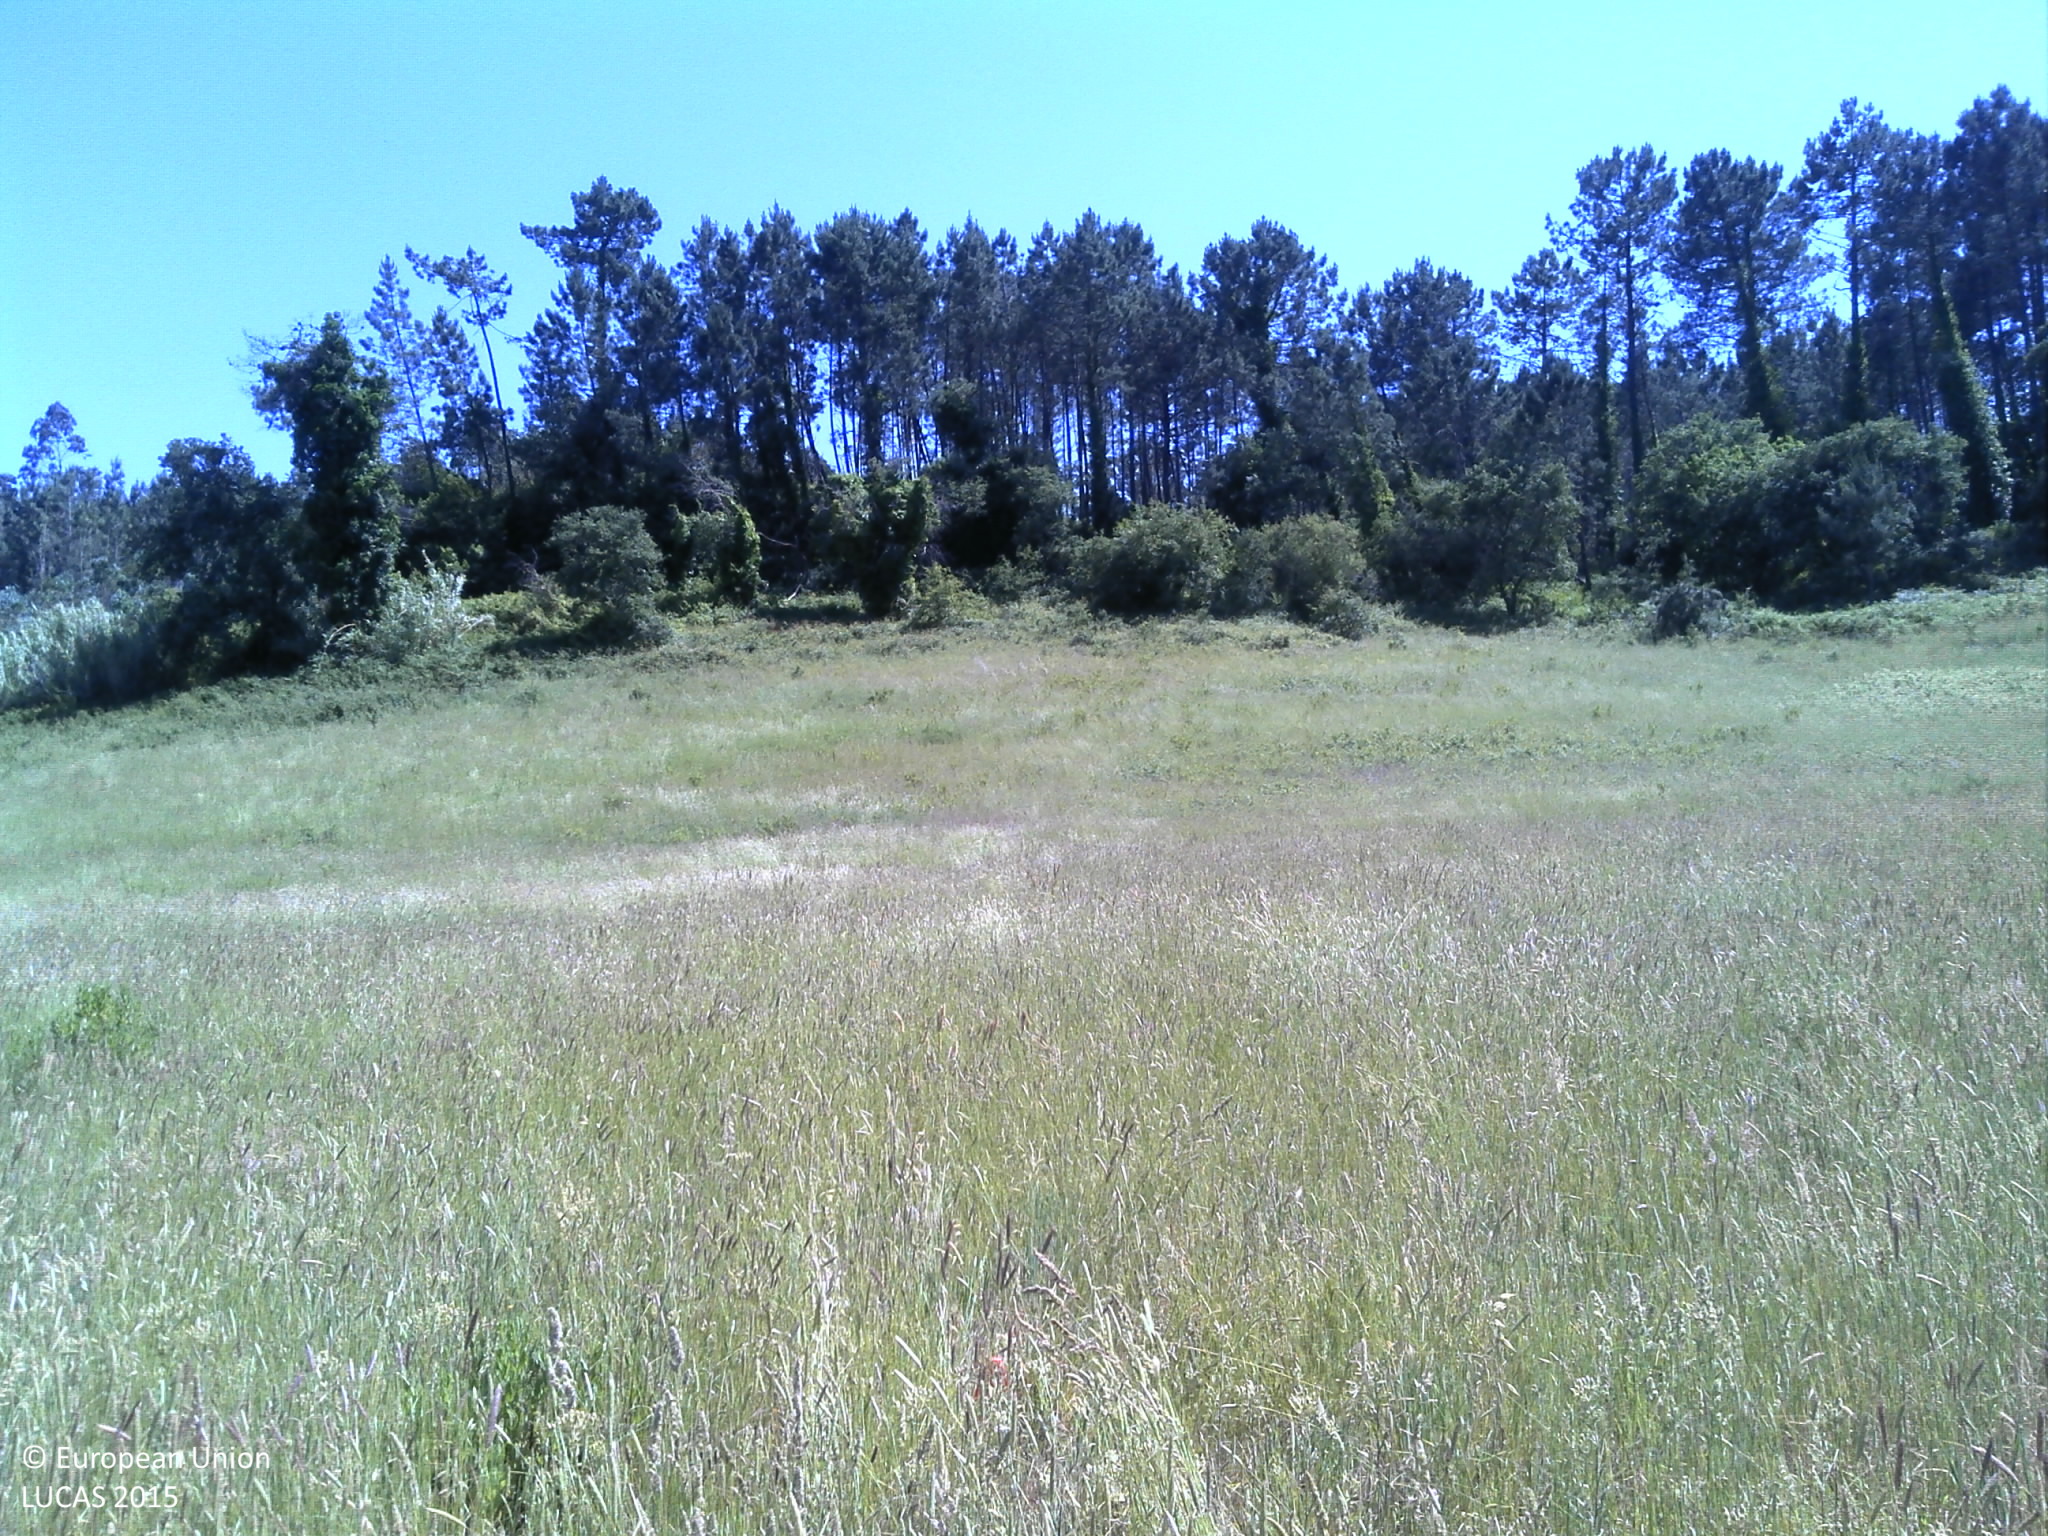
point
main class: Grassland
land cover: Grassland without tree/shrub cover
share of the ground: 50 - 75 %
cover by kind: herbaceous plants 80 %, unconsolidated bare surface 15 %, shrubs 5 %
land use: Agriculture (excluding fallow land and kitchen gardens)
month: June
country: PT
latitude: 39.6769
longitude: -8.8683
